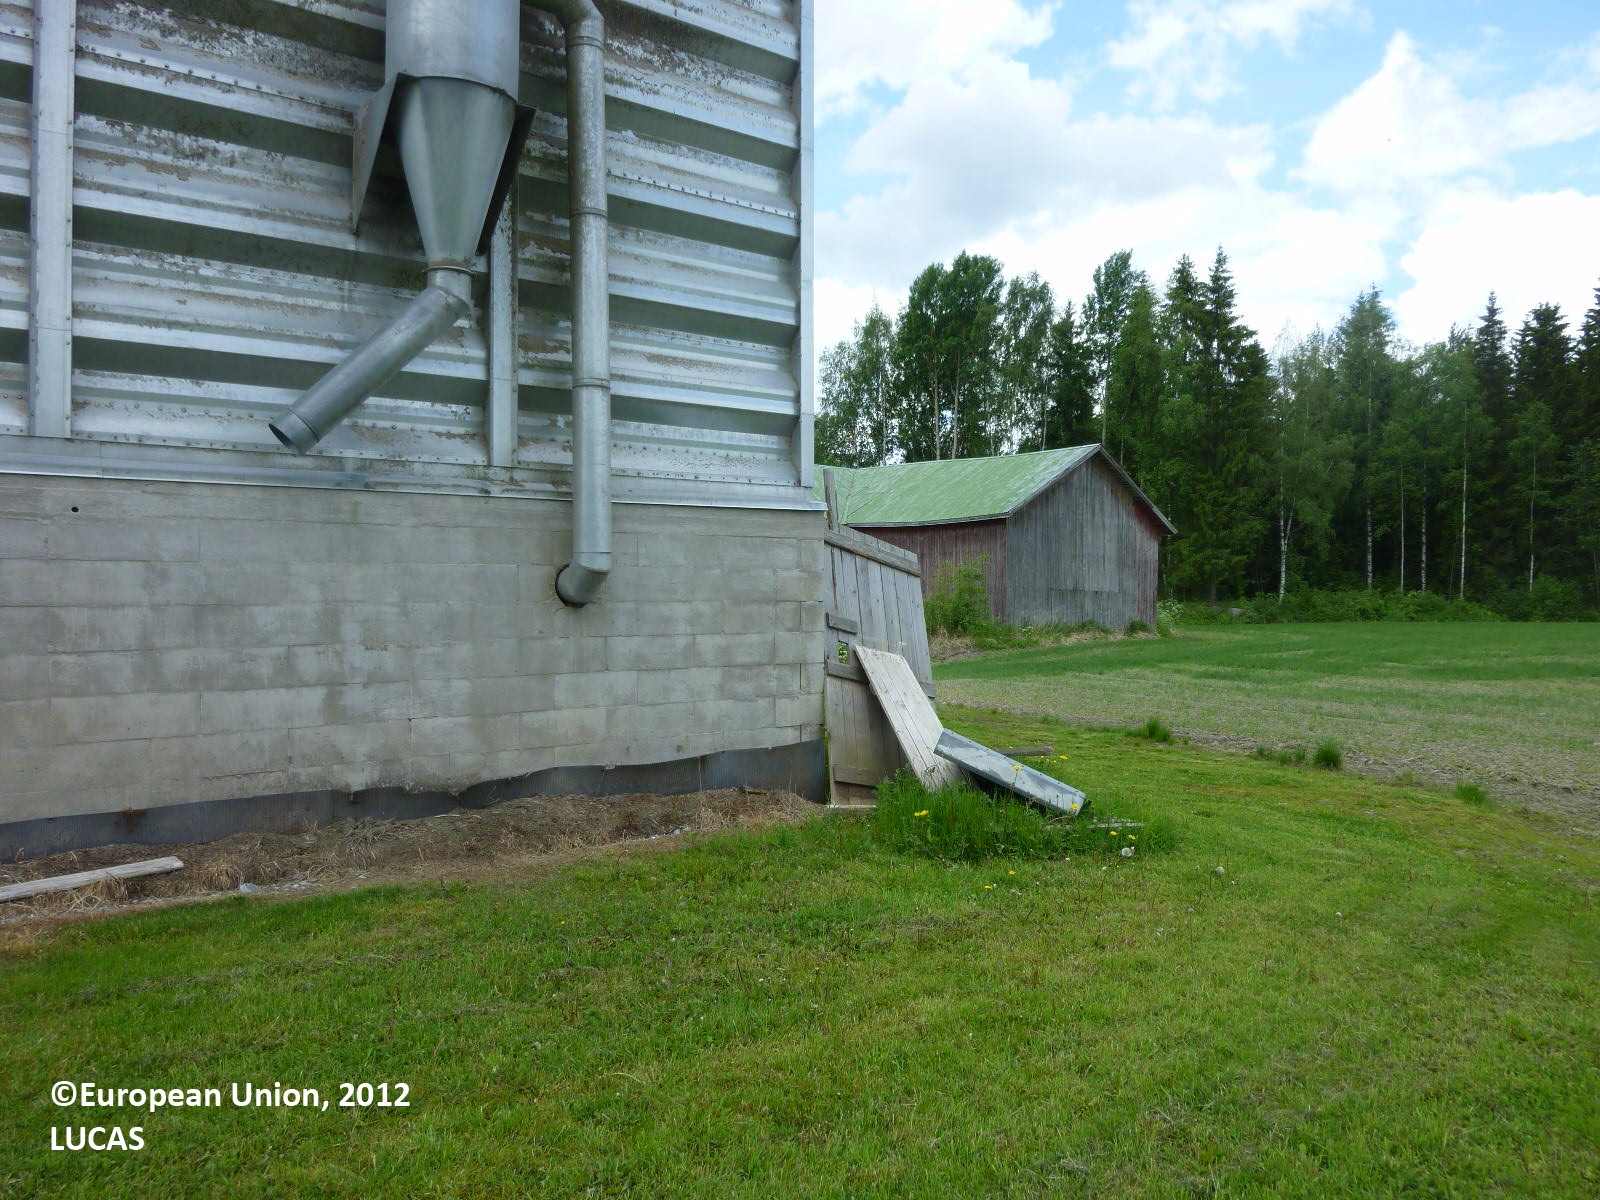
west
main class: Cropland
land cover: Barley
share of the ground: 50 - 75 %
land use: Agriculture (excluding fallow land and kitchen gardens)
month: June
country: FI
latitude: 61.4073
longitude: 22.5586
